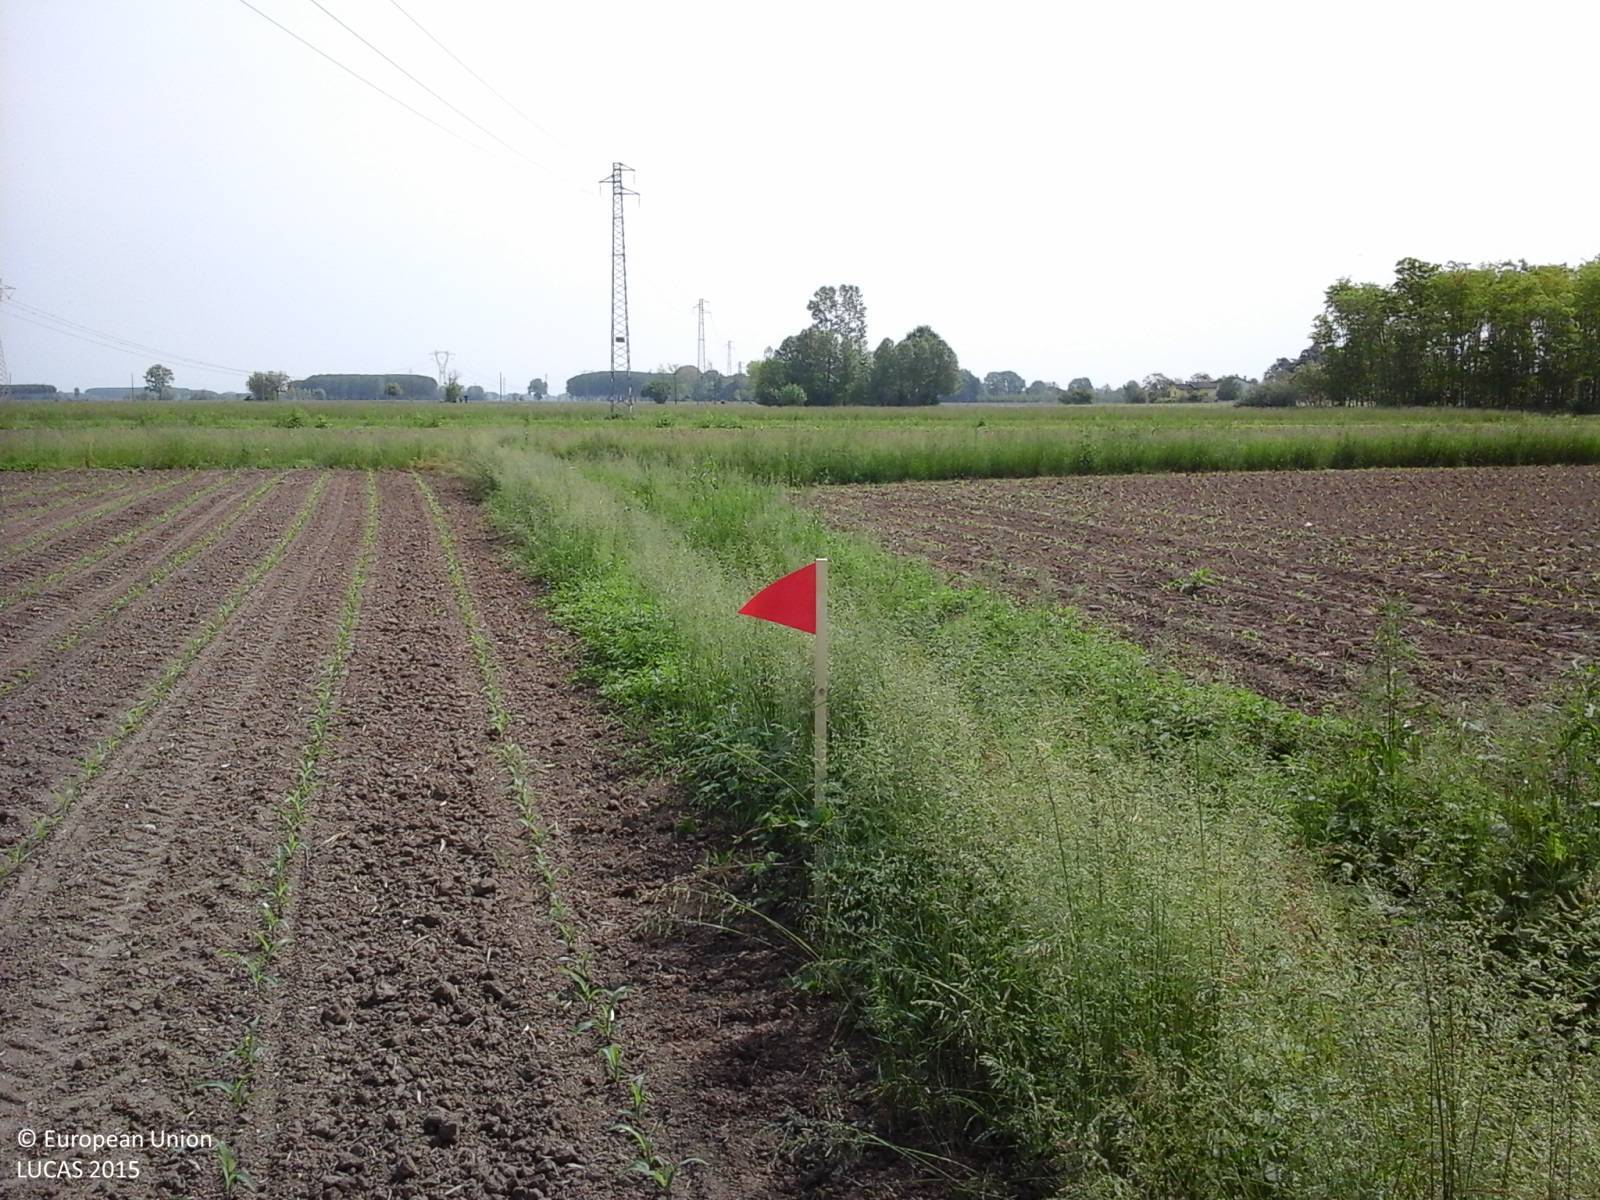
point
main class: Cropland
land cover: Maize
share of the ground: < 10 %
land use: Agriculture (excluding fallow land and kitchen gardens)
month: May
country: IT
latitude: 45.8218
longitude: 13.0209
